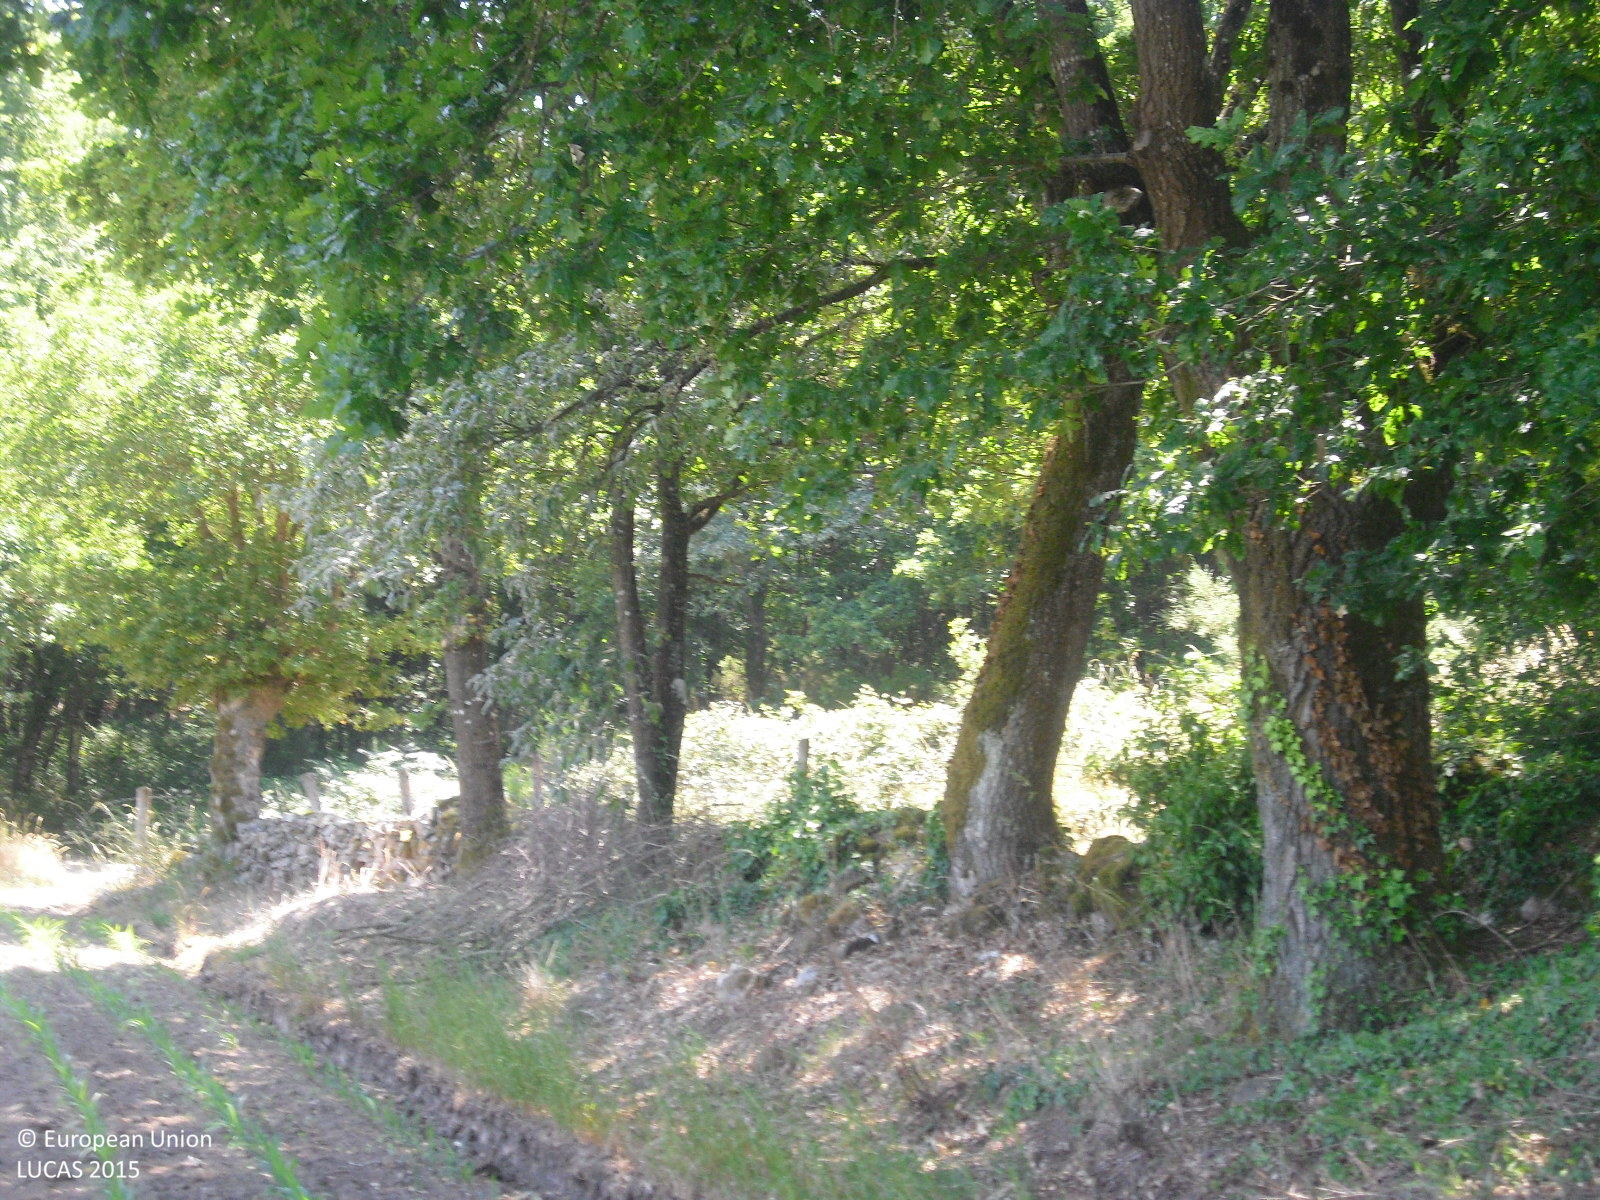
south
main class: Cropland
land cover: Maize
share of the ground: 25 - 50 %
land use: Agriculture (excluding fallow land and kitchen gardens)
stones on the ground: < 10 %
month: June
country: ES
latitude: 42.6526
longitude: -7.7785
